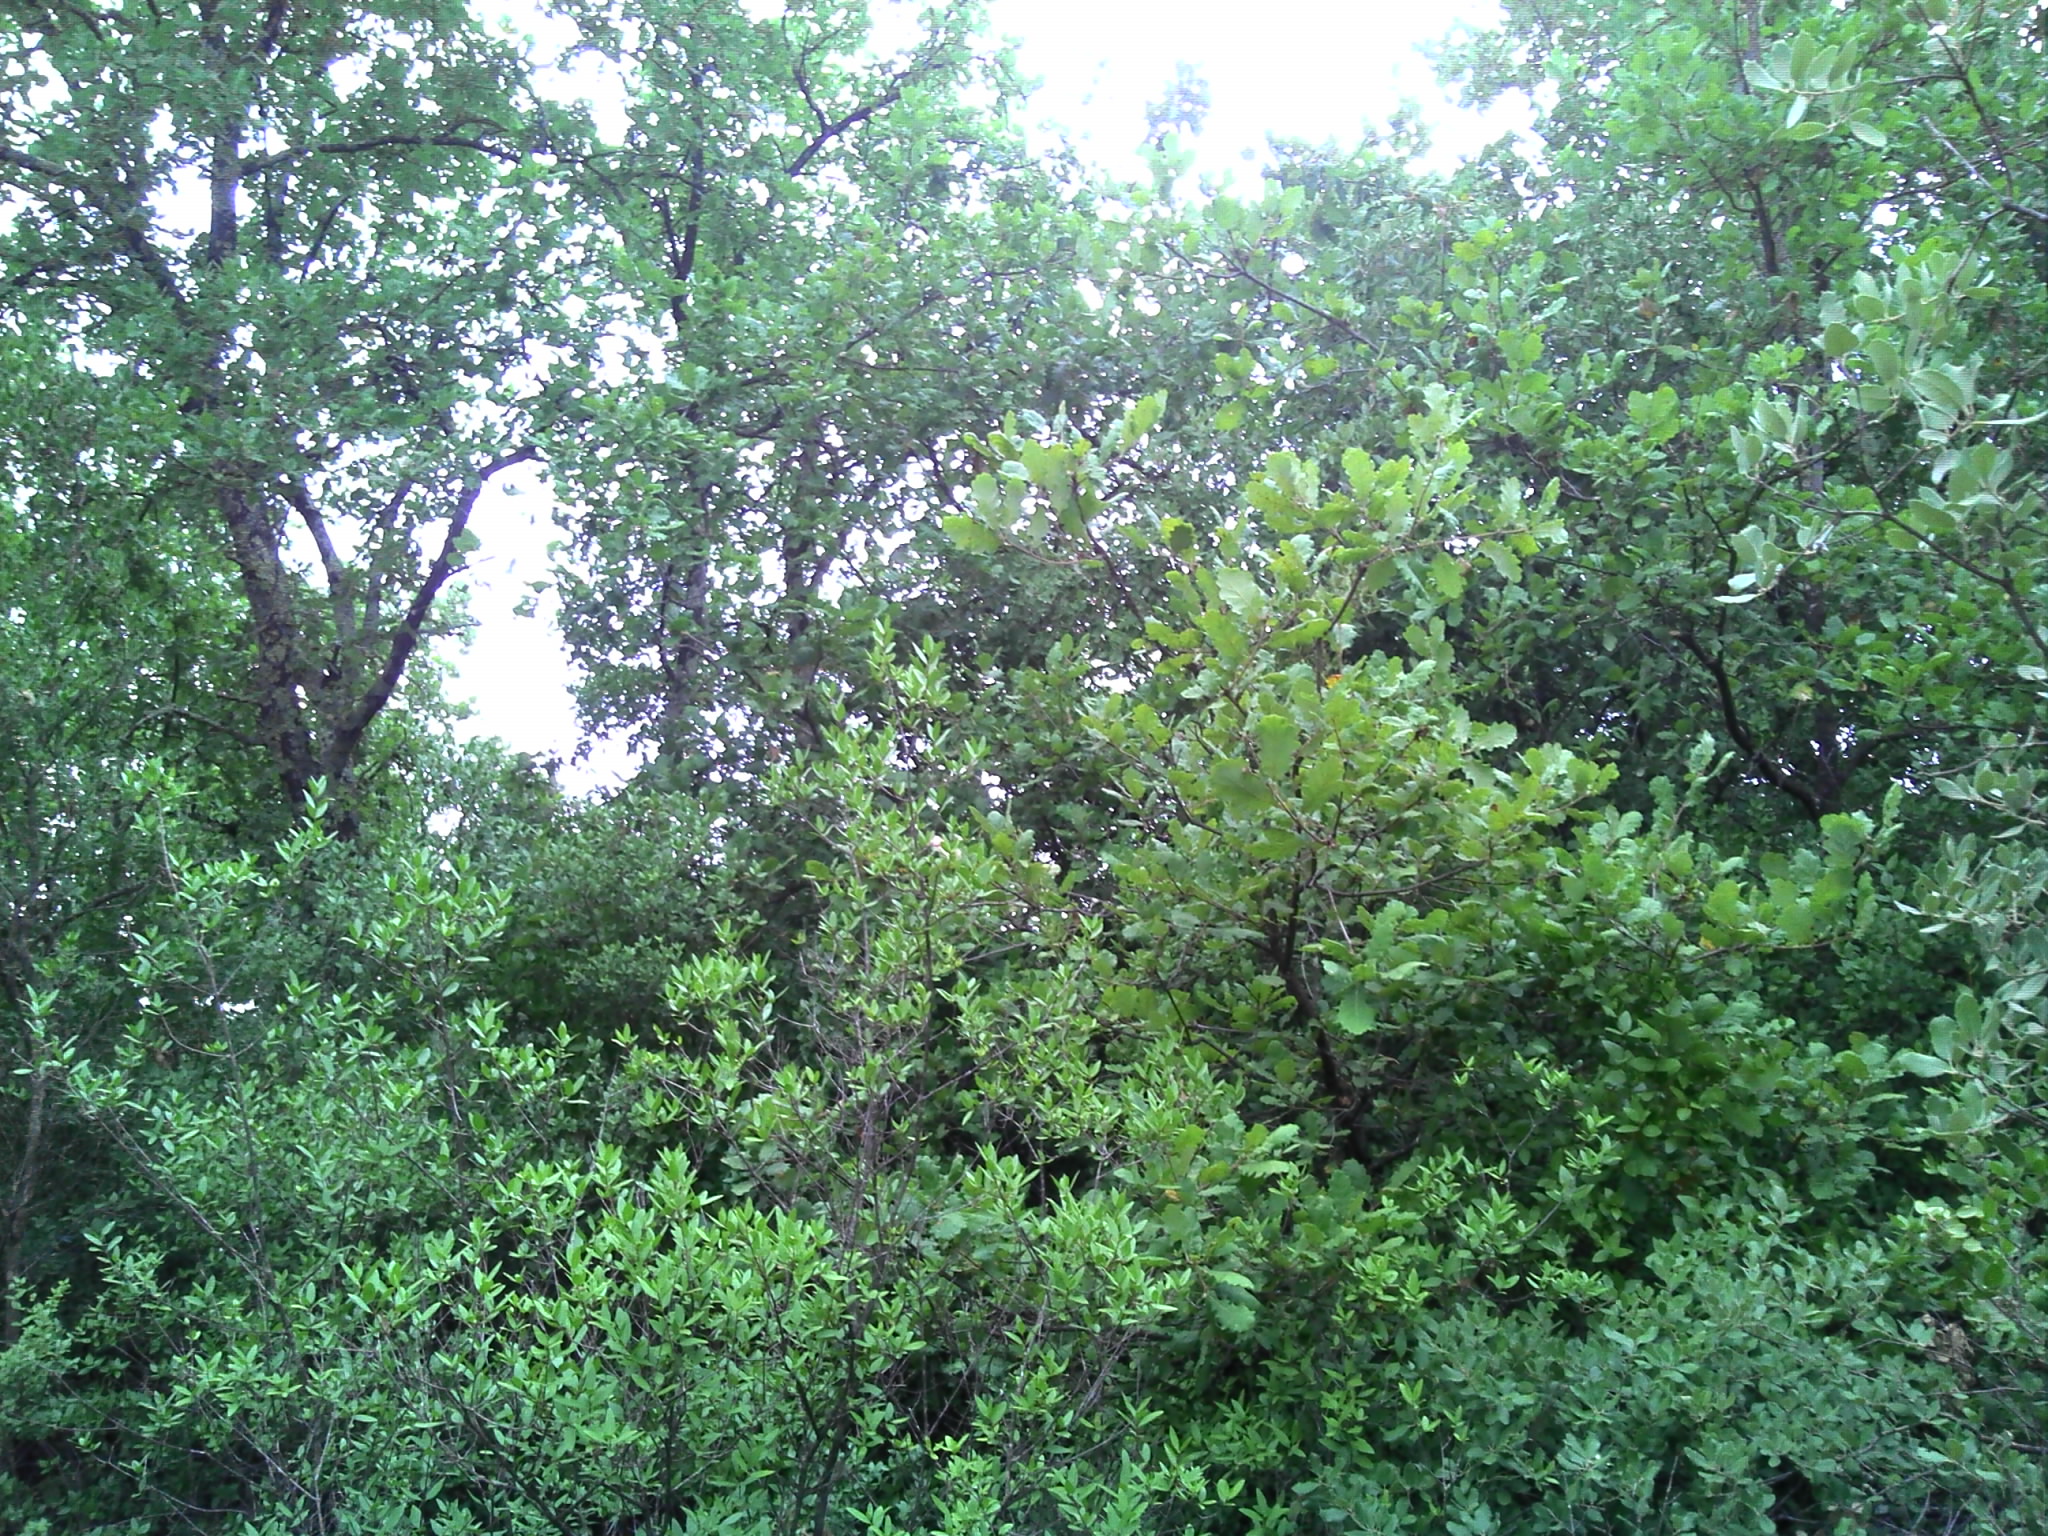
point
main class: Woodland
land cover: Broadleaved woodland
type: broadleaved evergreen forest
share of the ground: > 75 %
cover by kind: broadleaved forest trees 80 %, shrubs 10 %, herbaceous plants 10 %
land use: Semi-natural and natural areas not in use
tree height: > 5 m
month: July
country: FR
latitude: 43.9398
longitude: 3.9658
